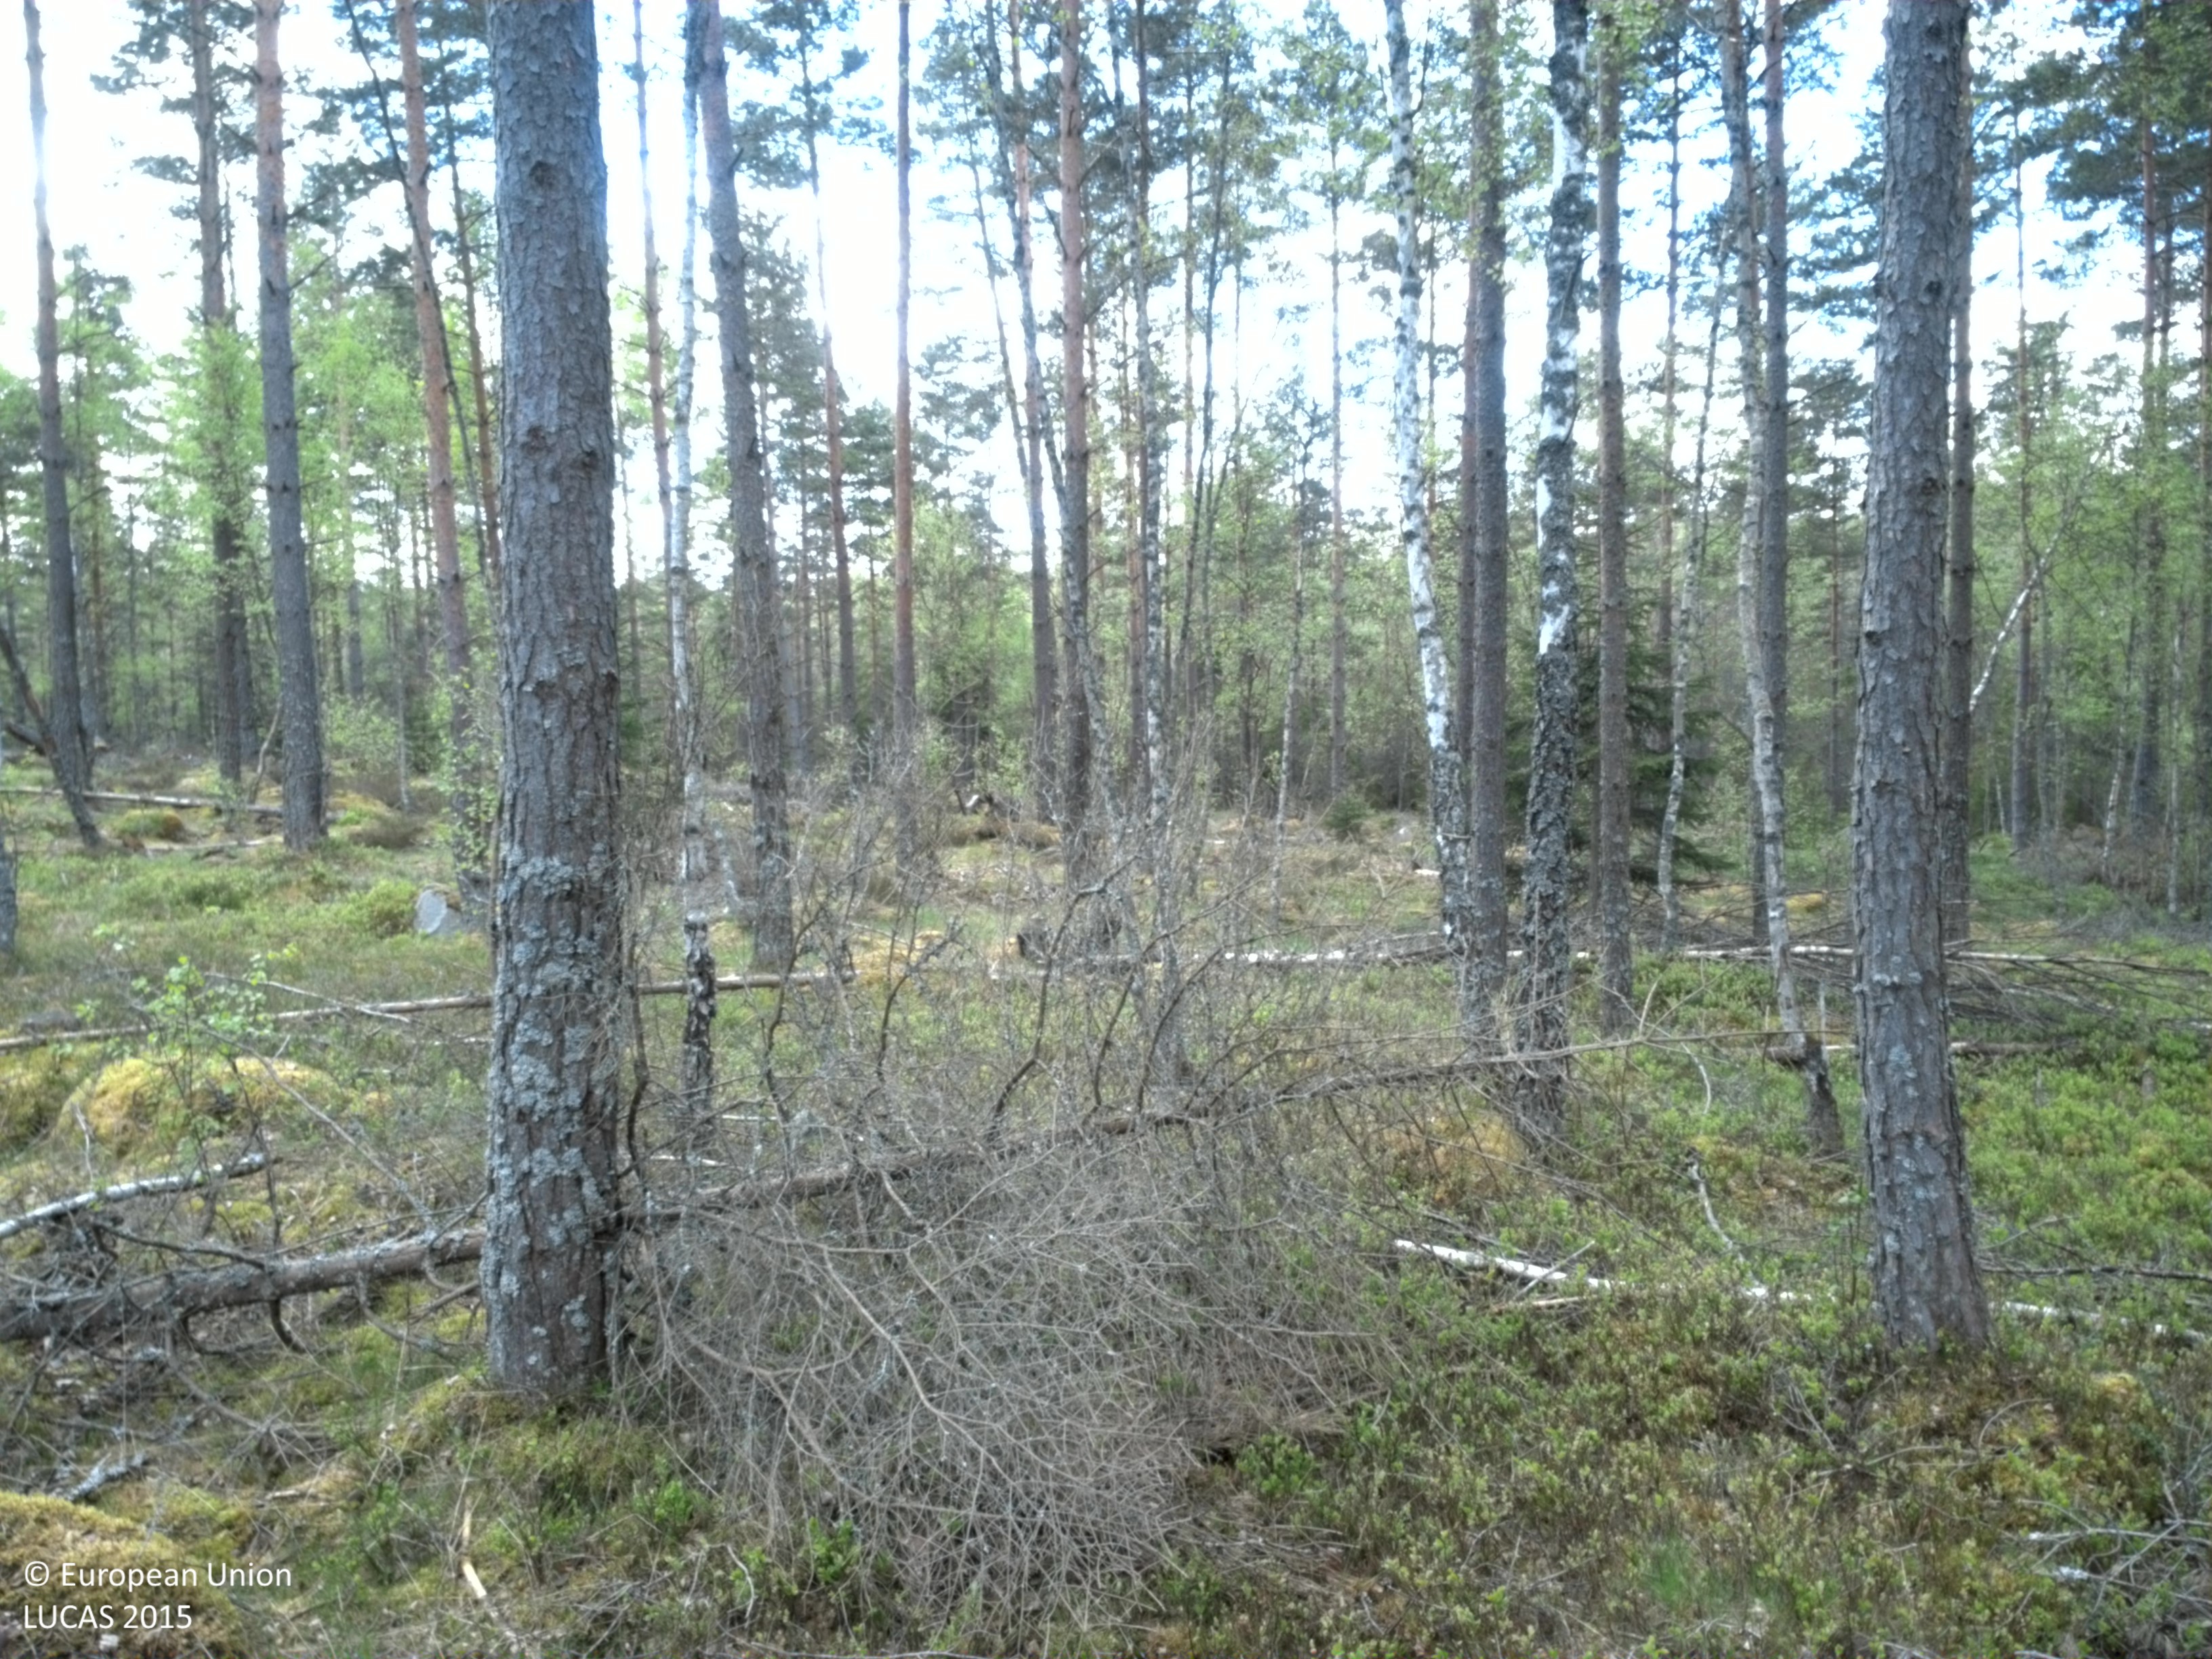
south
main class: Woodland
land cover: Pine dominated coniferous woodland
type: boreal forest
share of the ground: 25 - 50 %
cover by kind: shrubs 30 %, lichens and mosses 30 %, coniferous forest trees 25 %, herbaceous plants 10 %, broadleaved forest trees 5 %
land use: Forestry
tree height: > 5 m
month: May
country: SE
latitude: 56.7280
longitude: 15.2771
